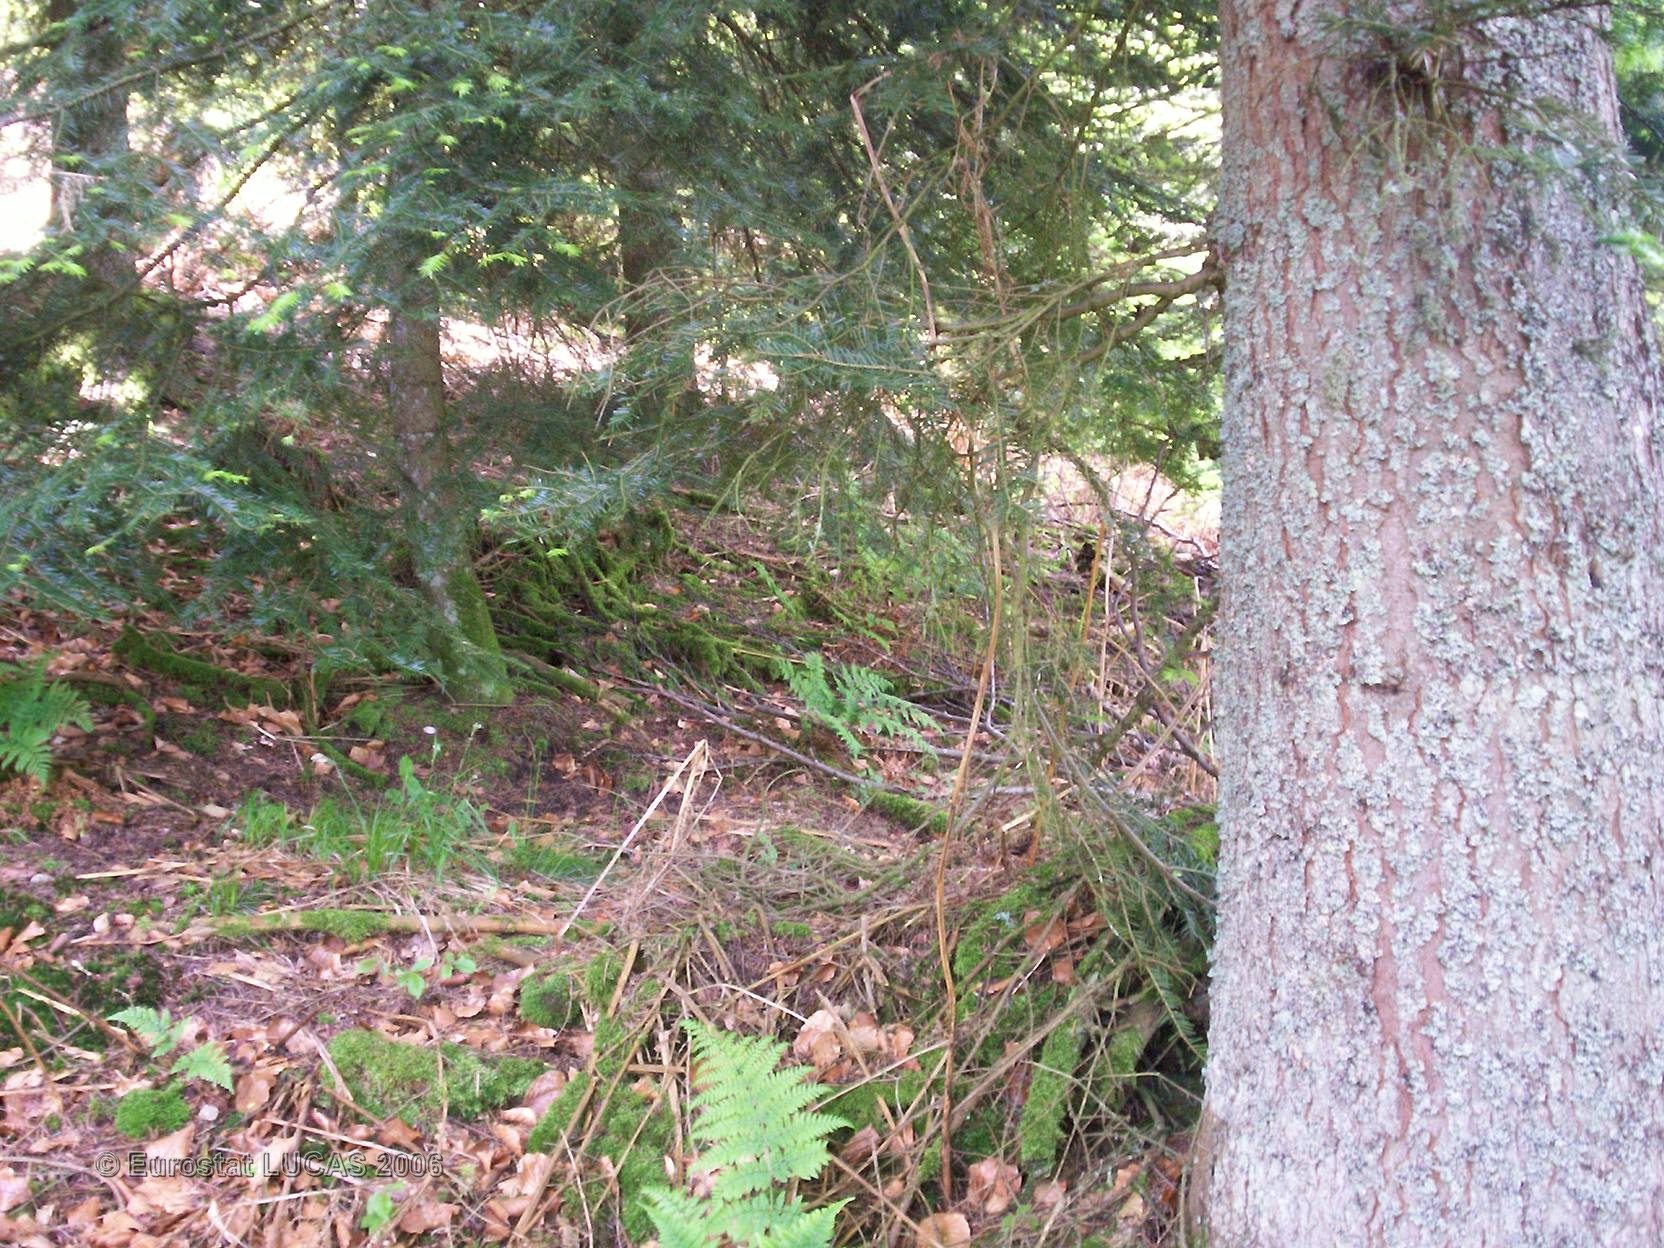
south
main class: Woodland
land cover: Mixed forest
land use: Forestry
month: May
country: FR
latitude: 48.0453
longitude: 6.6072
